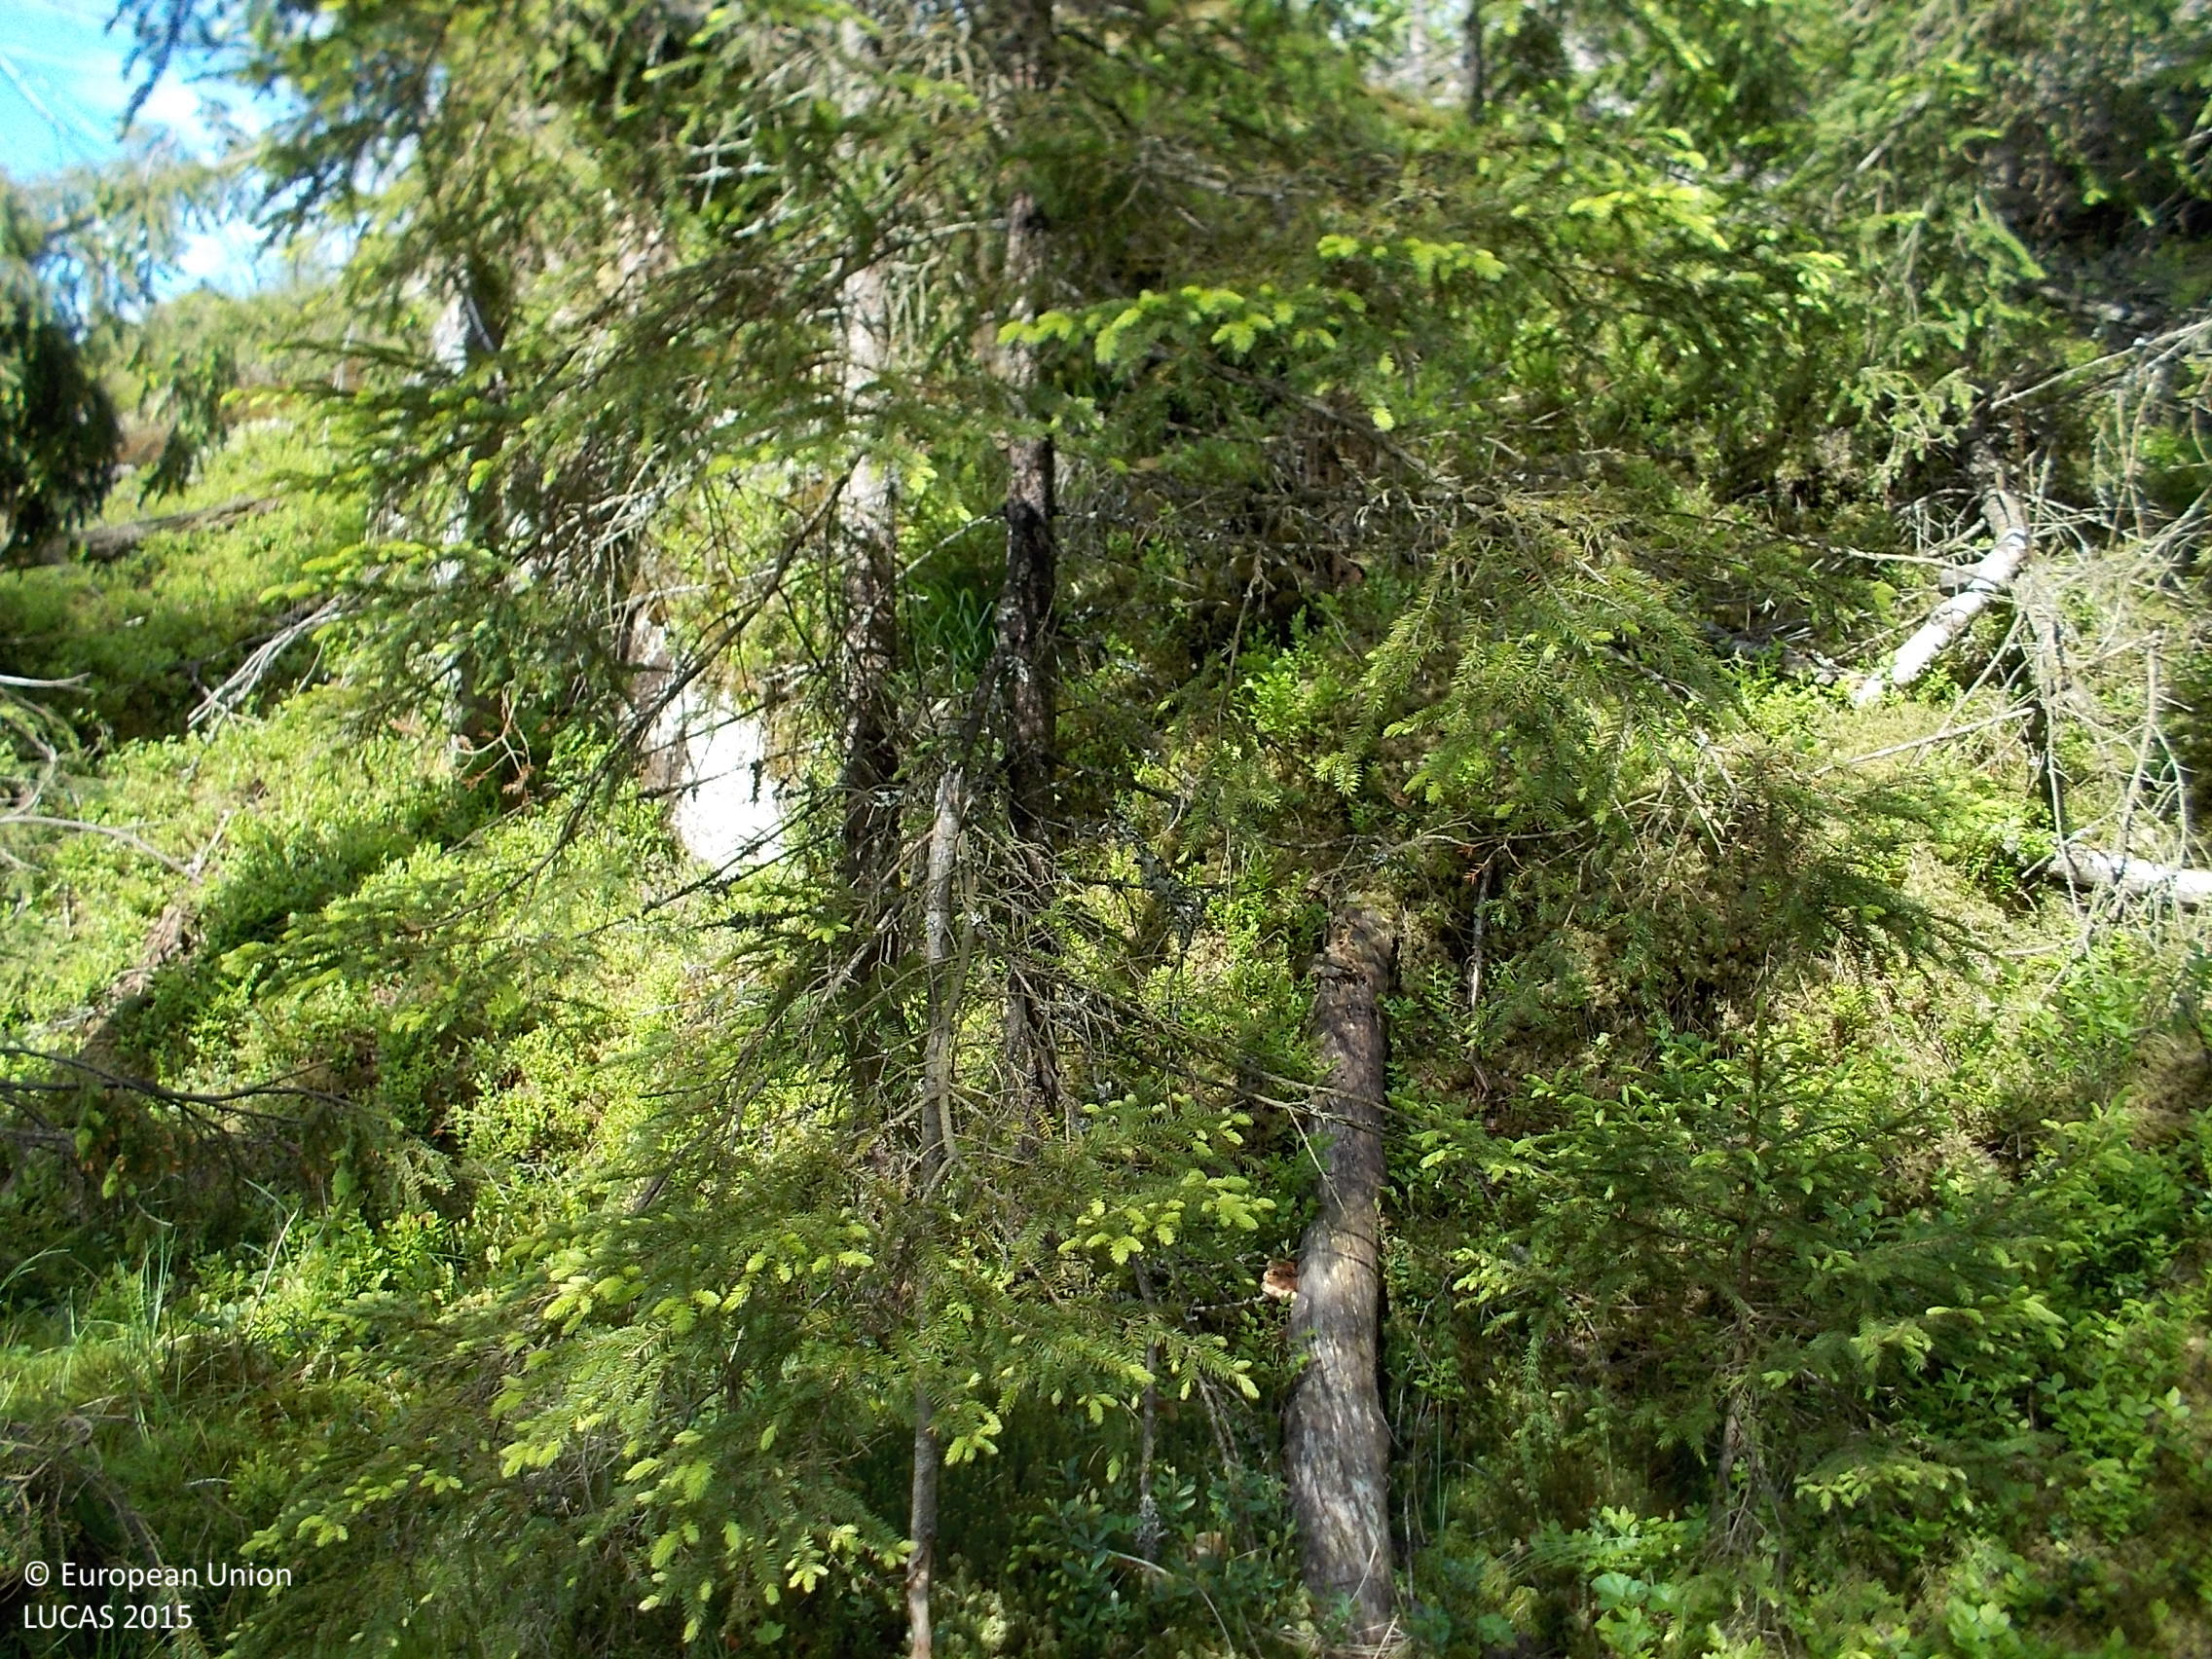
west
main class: Woodland
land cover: Spruce dominated mixed woodland
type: mire and swamp forests
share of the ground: 50 - 75 %
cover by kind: coniferous forest trees 40 %, broadleaved forest trees 20 %, herbaceous plants 20 %, lichens and mosses 20 %
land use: Semi-natural and natural areas not in use
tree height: > 5 m
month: June
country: SE
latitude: 57.6799
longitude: 13.0979
